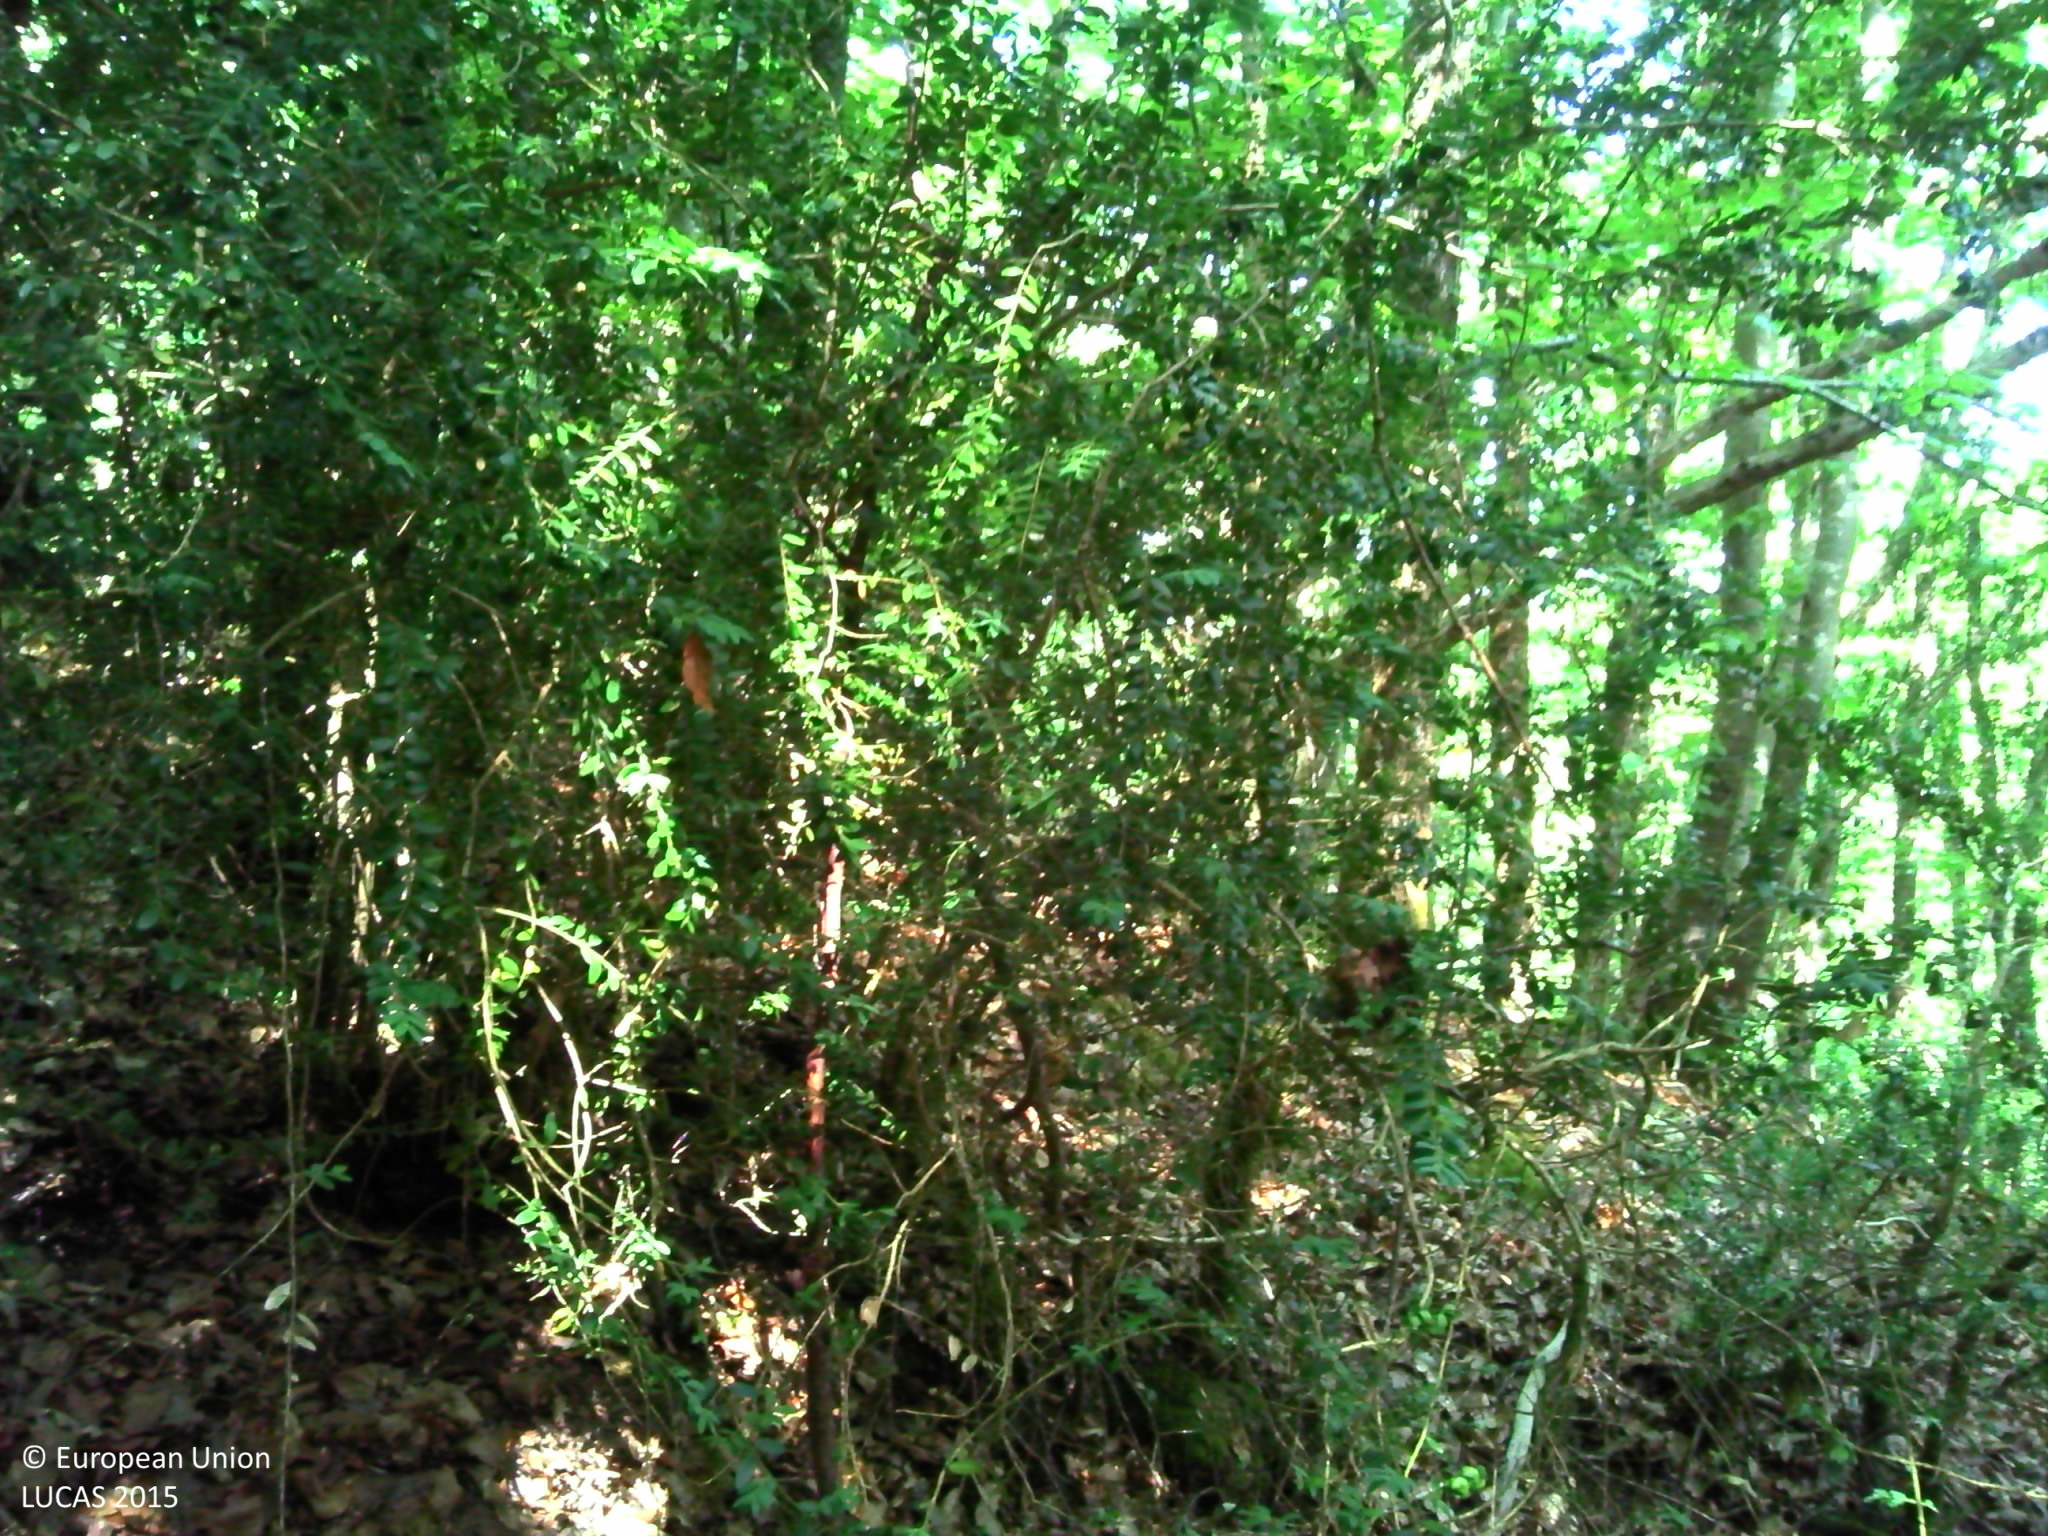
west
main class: Woodland
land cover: Broadleaved woodland
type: beech forest
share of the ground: > 75 %
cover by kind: broadleaved forest trees 80 %, herbaceous plants 10 %, shrubs 5 %, lichens and mosses 5 %
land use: Forestry
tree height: > 5 m
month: August
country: FR
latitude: 43.8674
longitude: 3.1009
